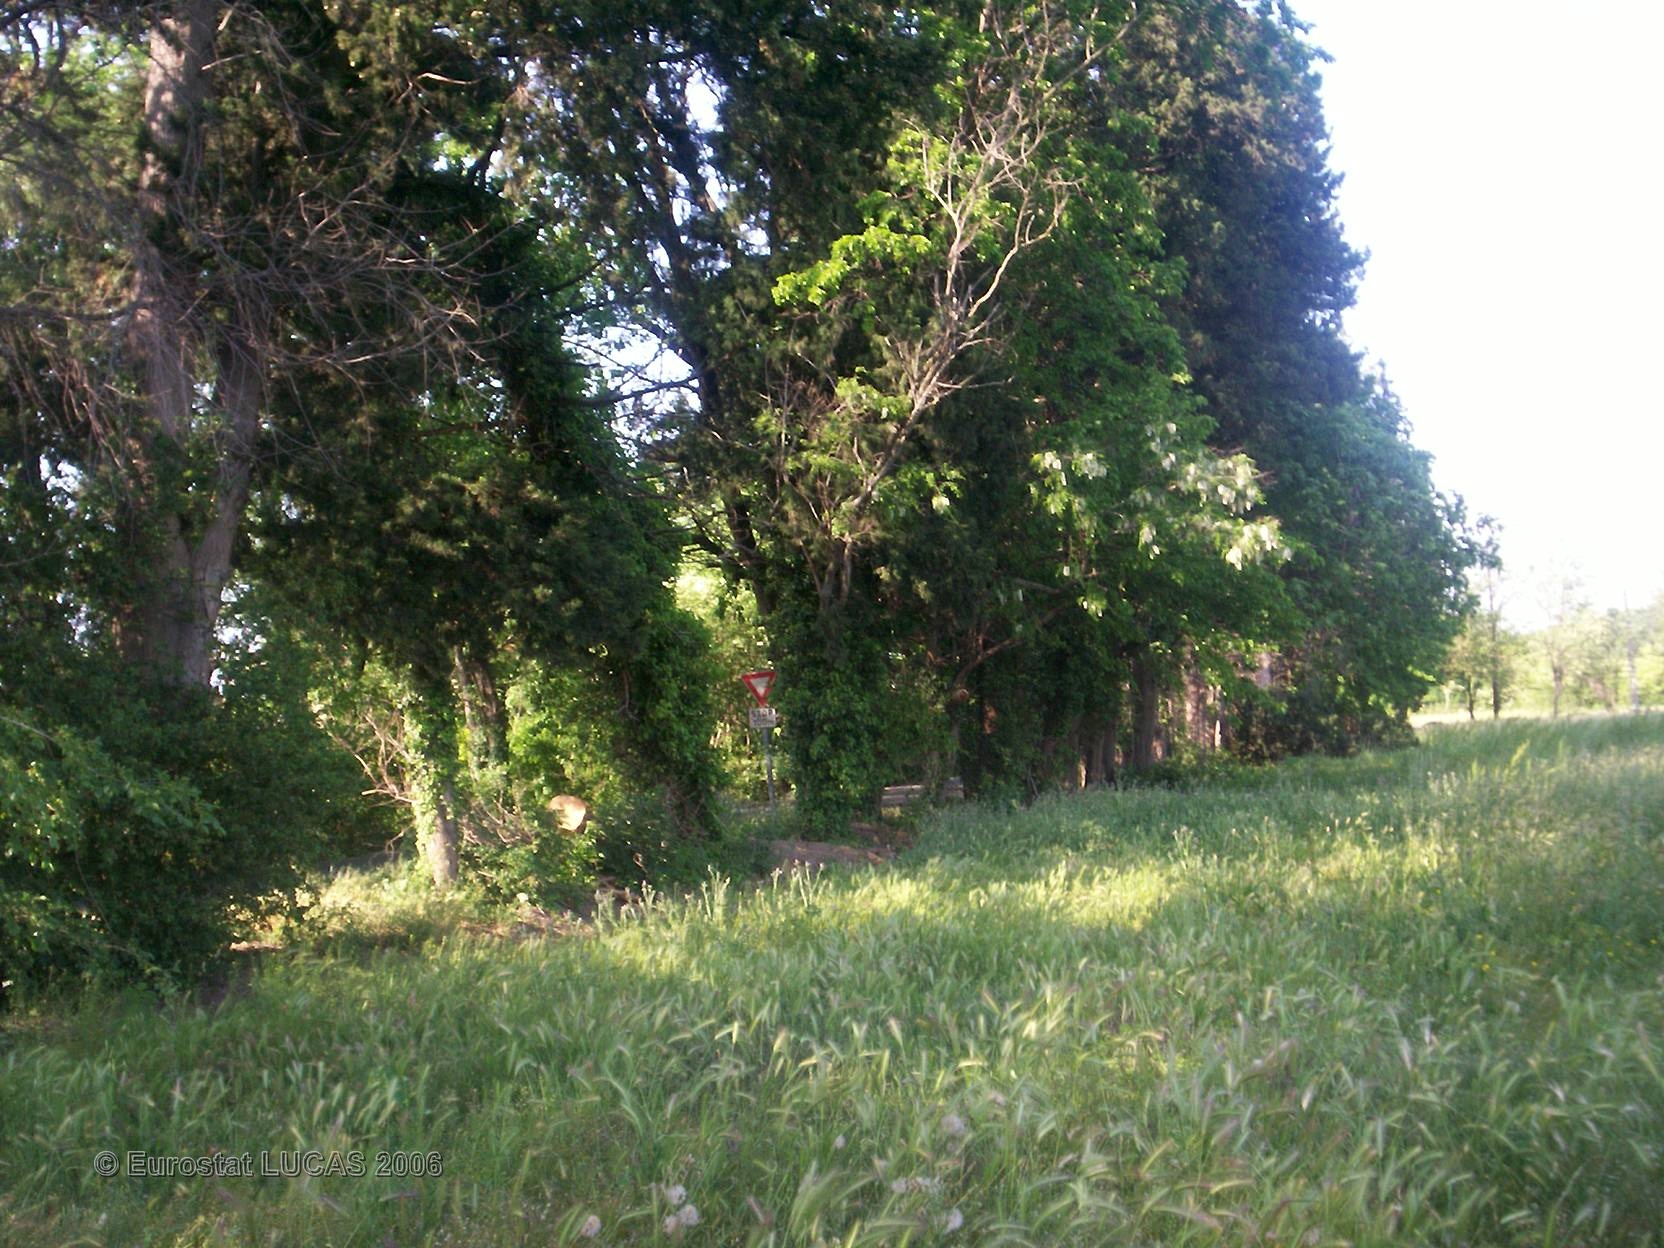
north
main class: Grassland
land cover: Grassland without tree/shrub cover
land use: Agriculture (excluding fallow land and kitchen gardens)
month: May
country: FR
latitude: 43.9355
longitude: 4.8886
